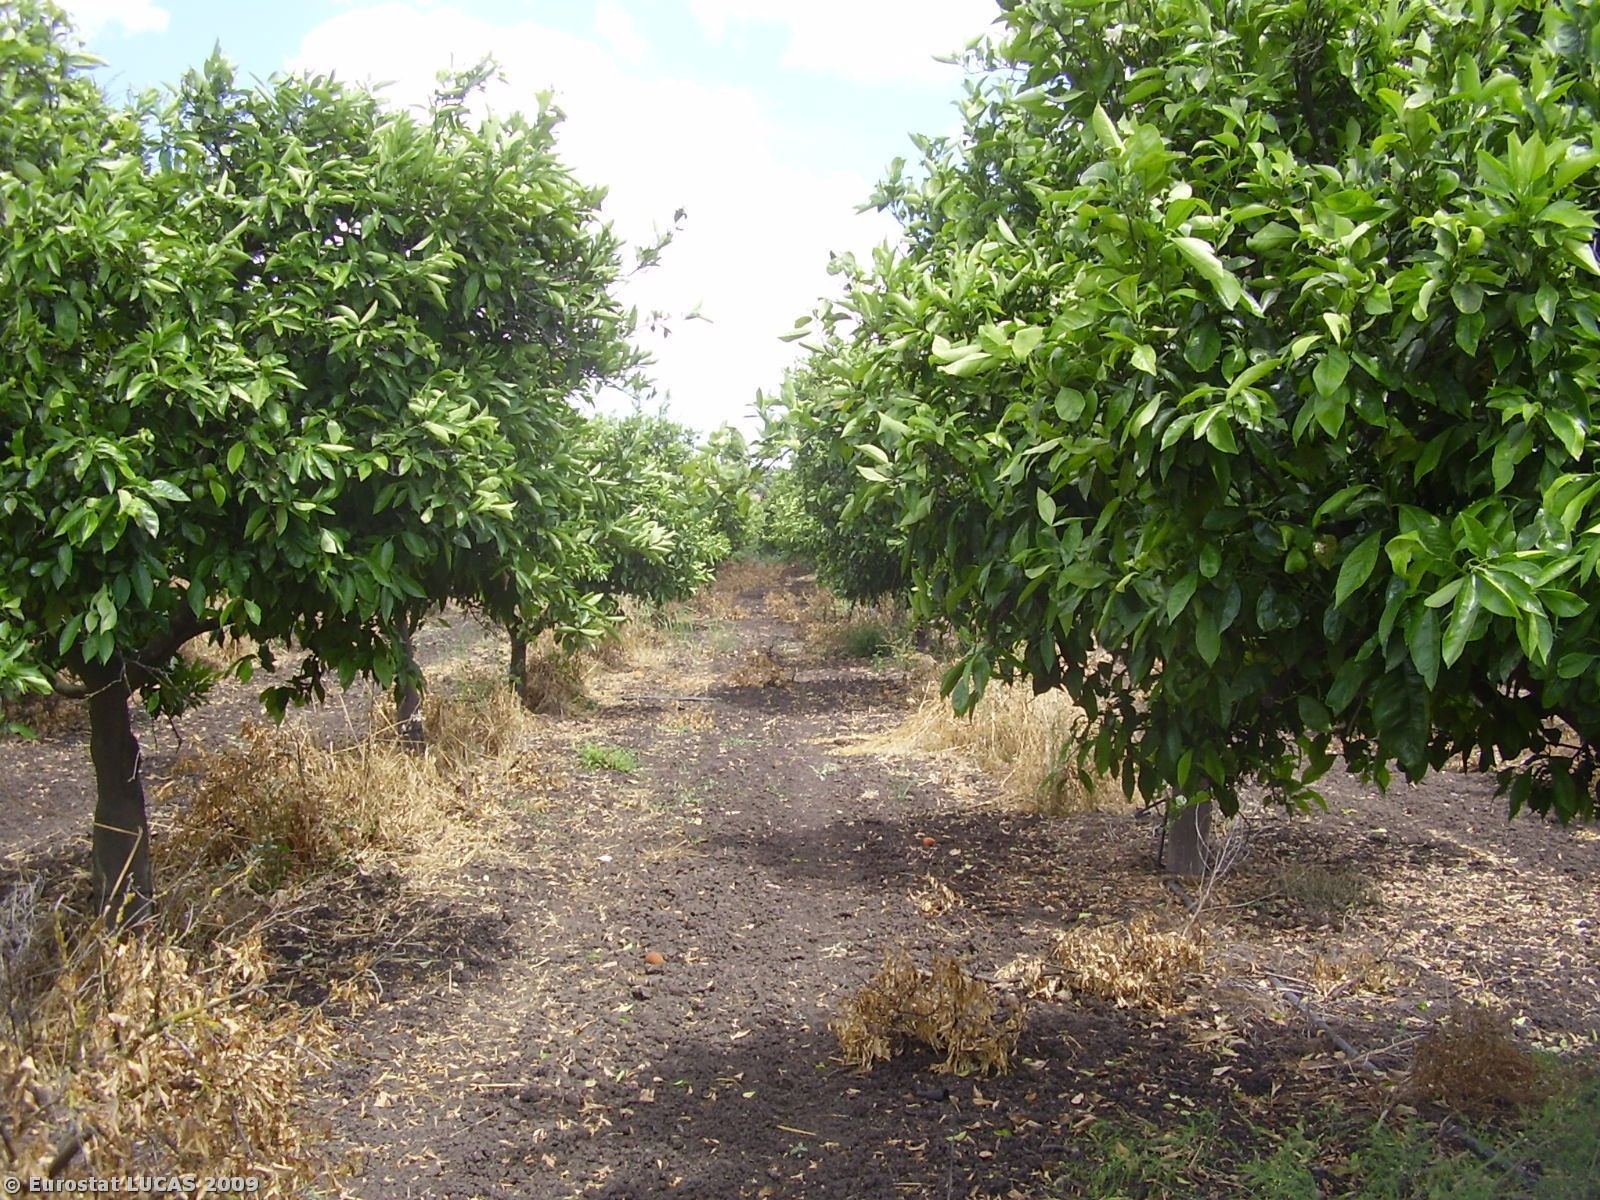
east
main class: Cropland
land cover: Oranges
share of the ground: 50 - 75 %
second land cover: Bare land
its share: > 75 %
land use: Agriculture (excluding fallow land and kitchen gardens)
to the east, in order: Oranges; Bare land; Ditches and canals; Inland running water; Ditches and canals; Tracks; Electric lines; Ditches and canals; Oranges; Bare land
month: June
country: IT
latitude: 37.2930
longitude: 14.9154
